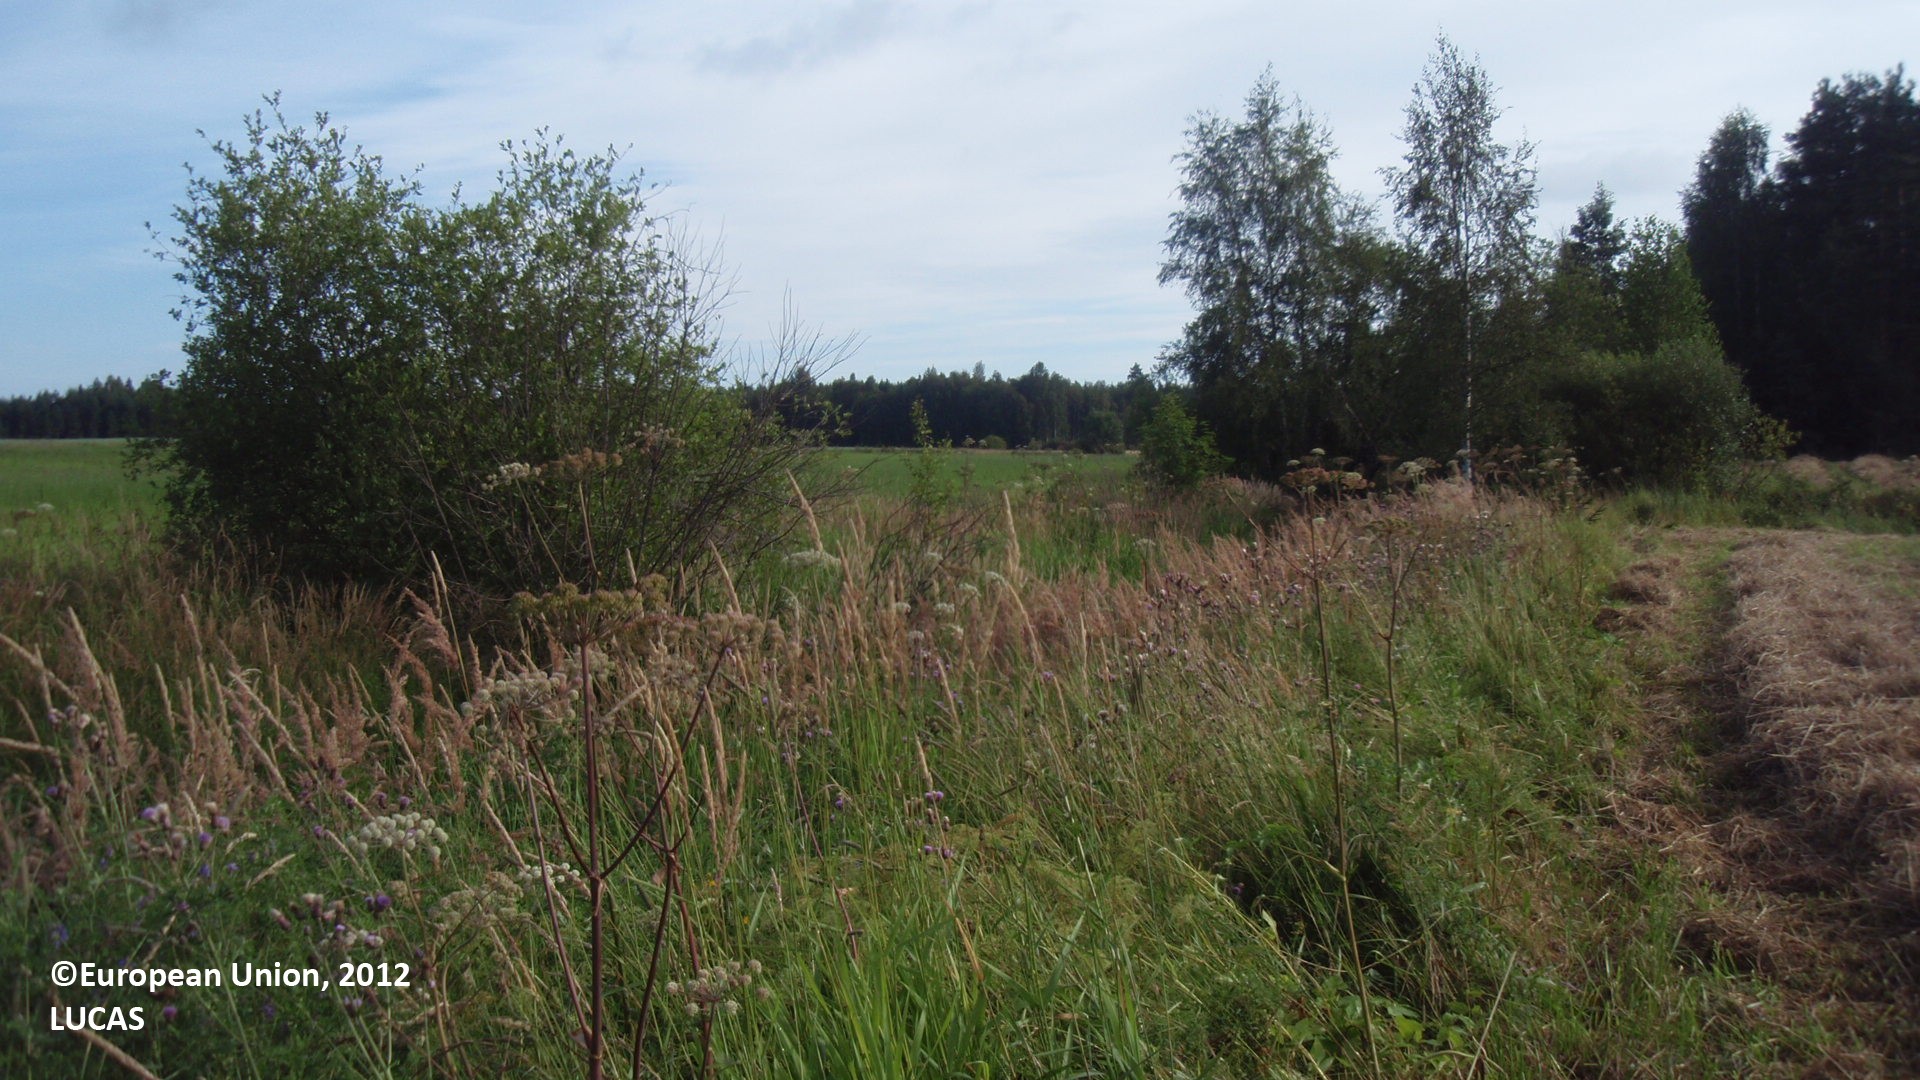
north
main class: Cropland
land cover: Mixed cereals for fodder
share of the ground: > 75 %
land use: Agriculture (excluding fallow land and kitchen gardens)
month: August
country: FI
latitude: 61.2134
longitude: 28.0128
